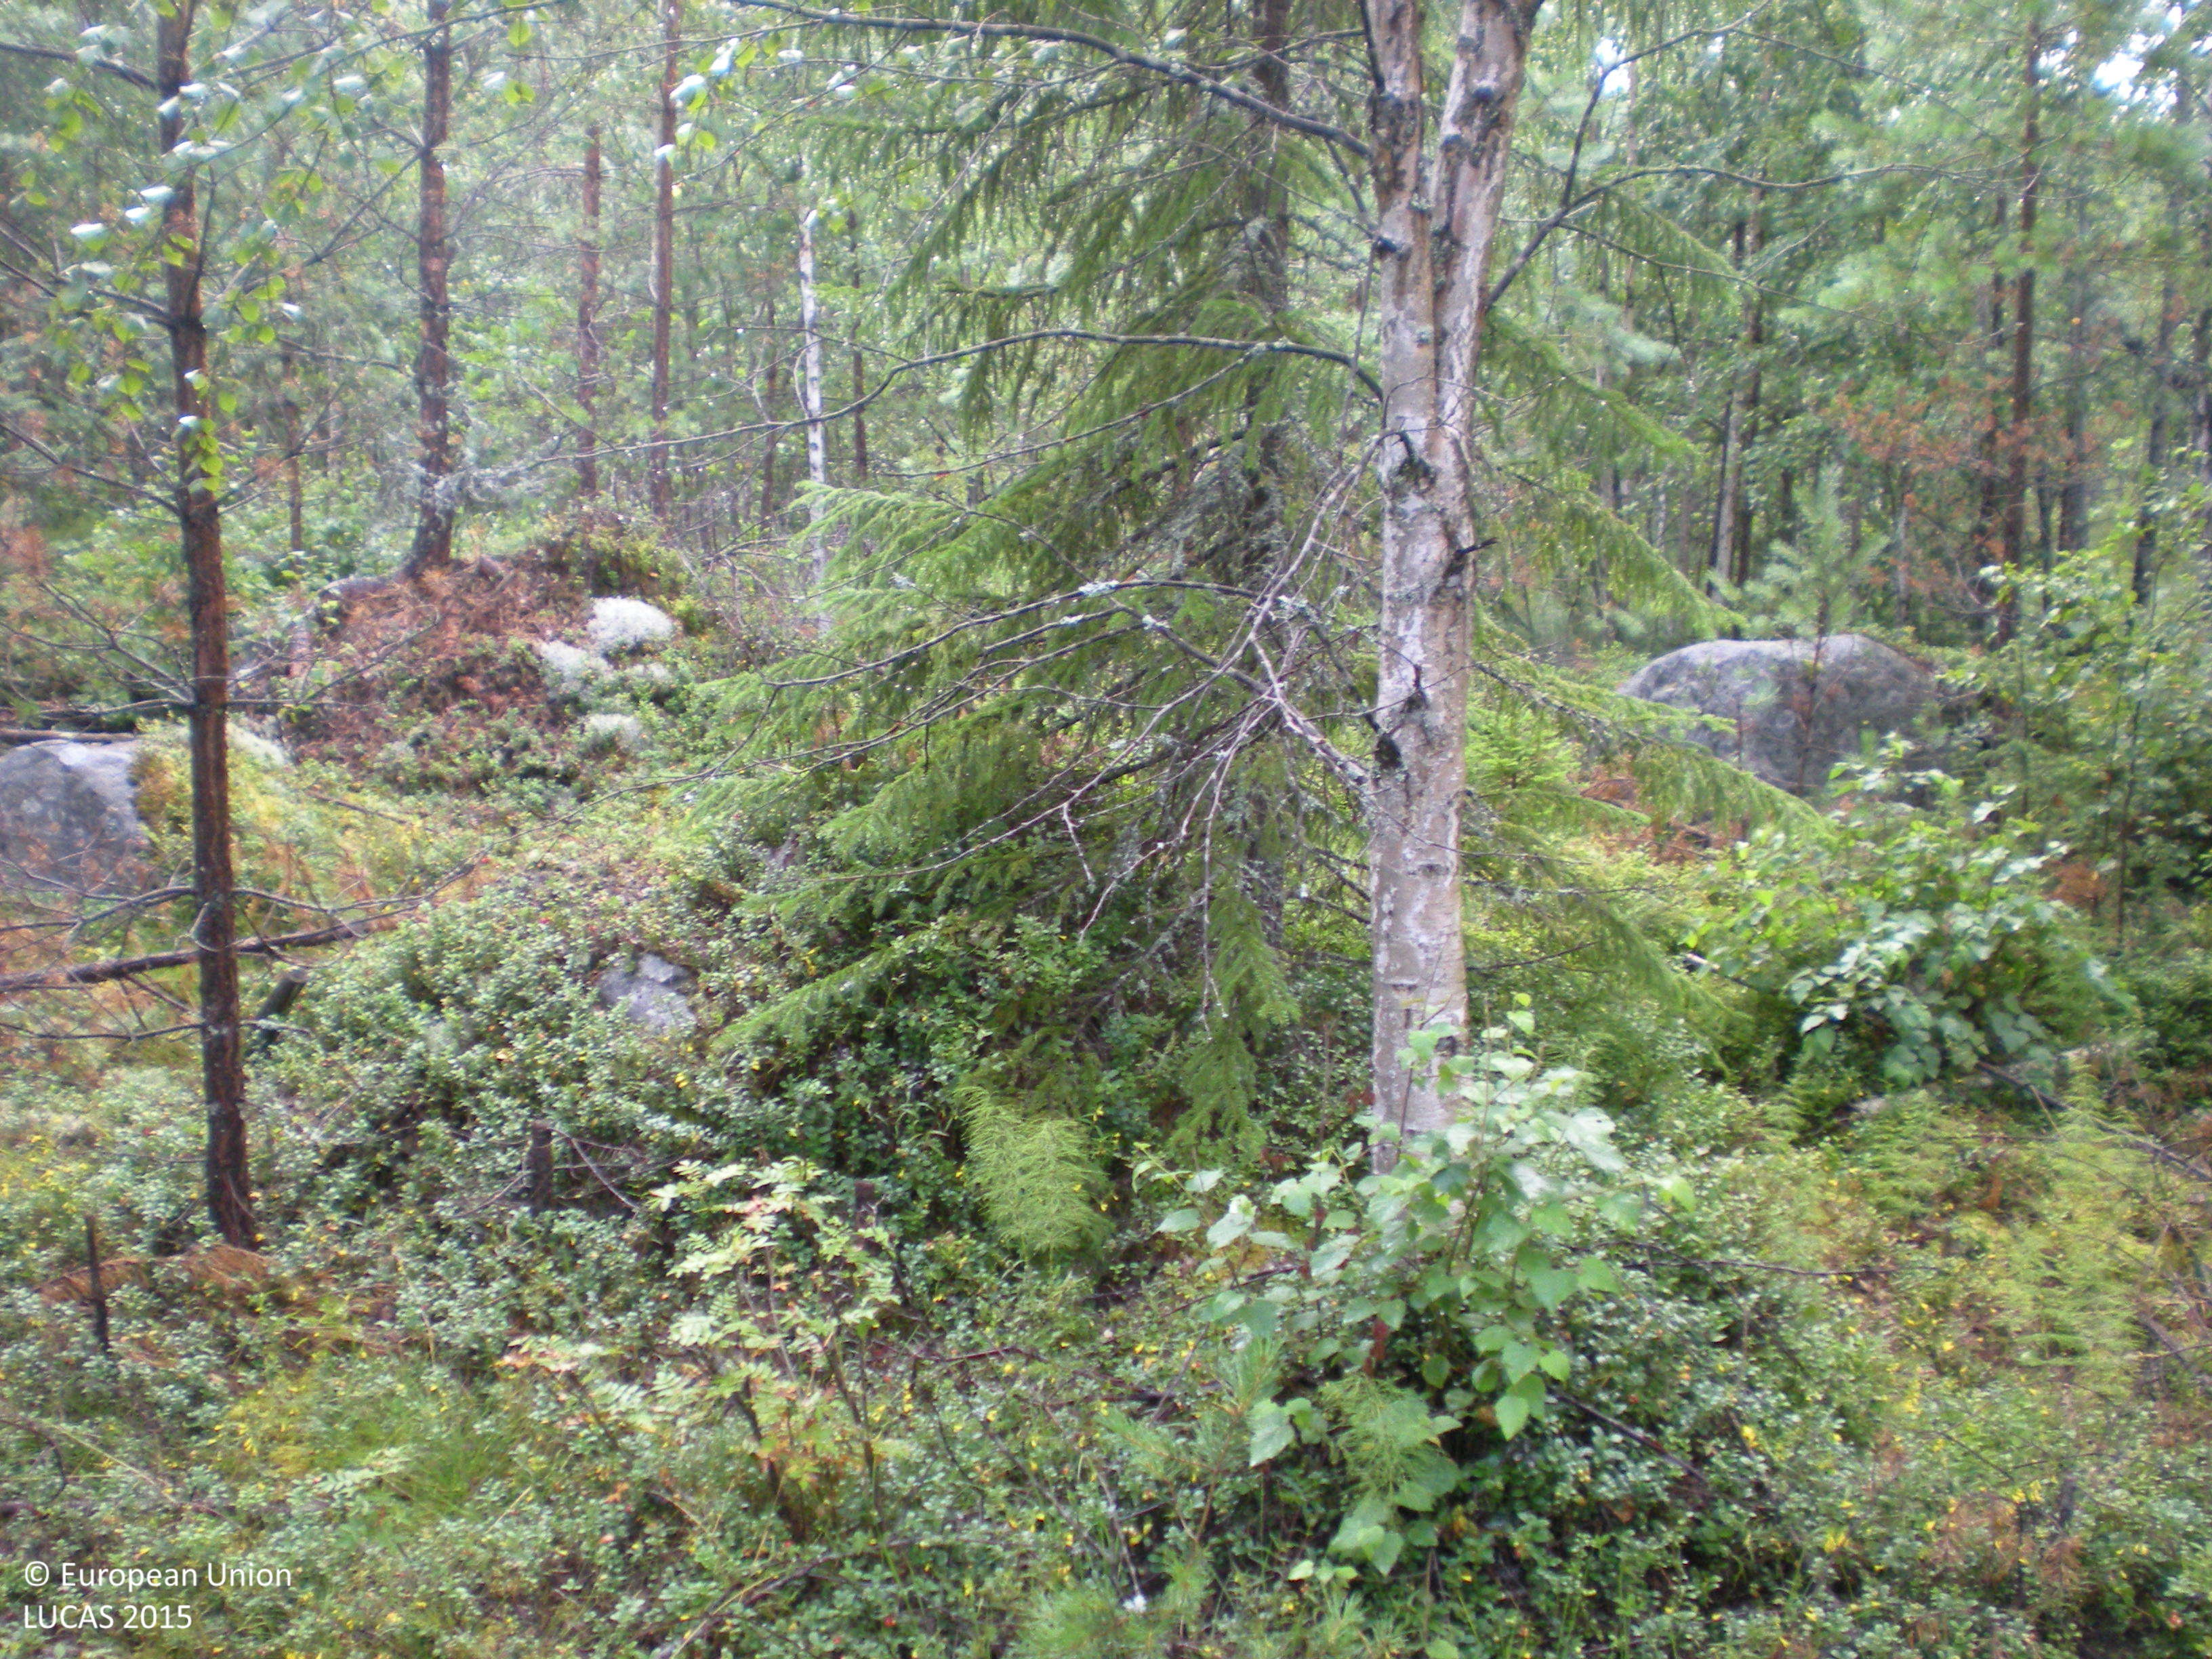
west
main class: Woodland
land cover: Pine dominated coniferous woodland
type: boreal forest
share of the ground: 50 - 75 %
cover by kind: coniferous forest trees 65 %, shrubs 15 %, broadleaved forest trees 5 %, herbaceous plants 5 %, lichens and mosses 5 %, consolidated bare surface 5 %
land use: Forestry
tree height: < 5 m
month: August
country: SE
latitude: 60.7349
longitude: 17.2694
